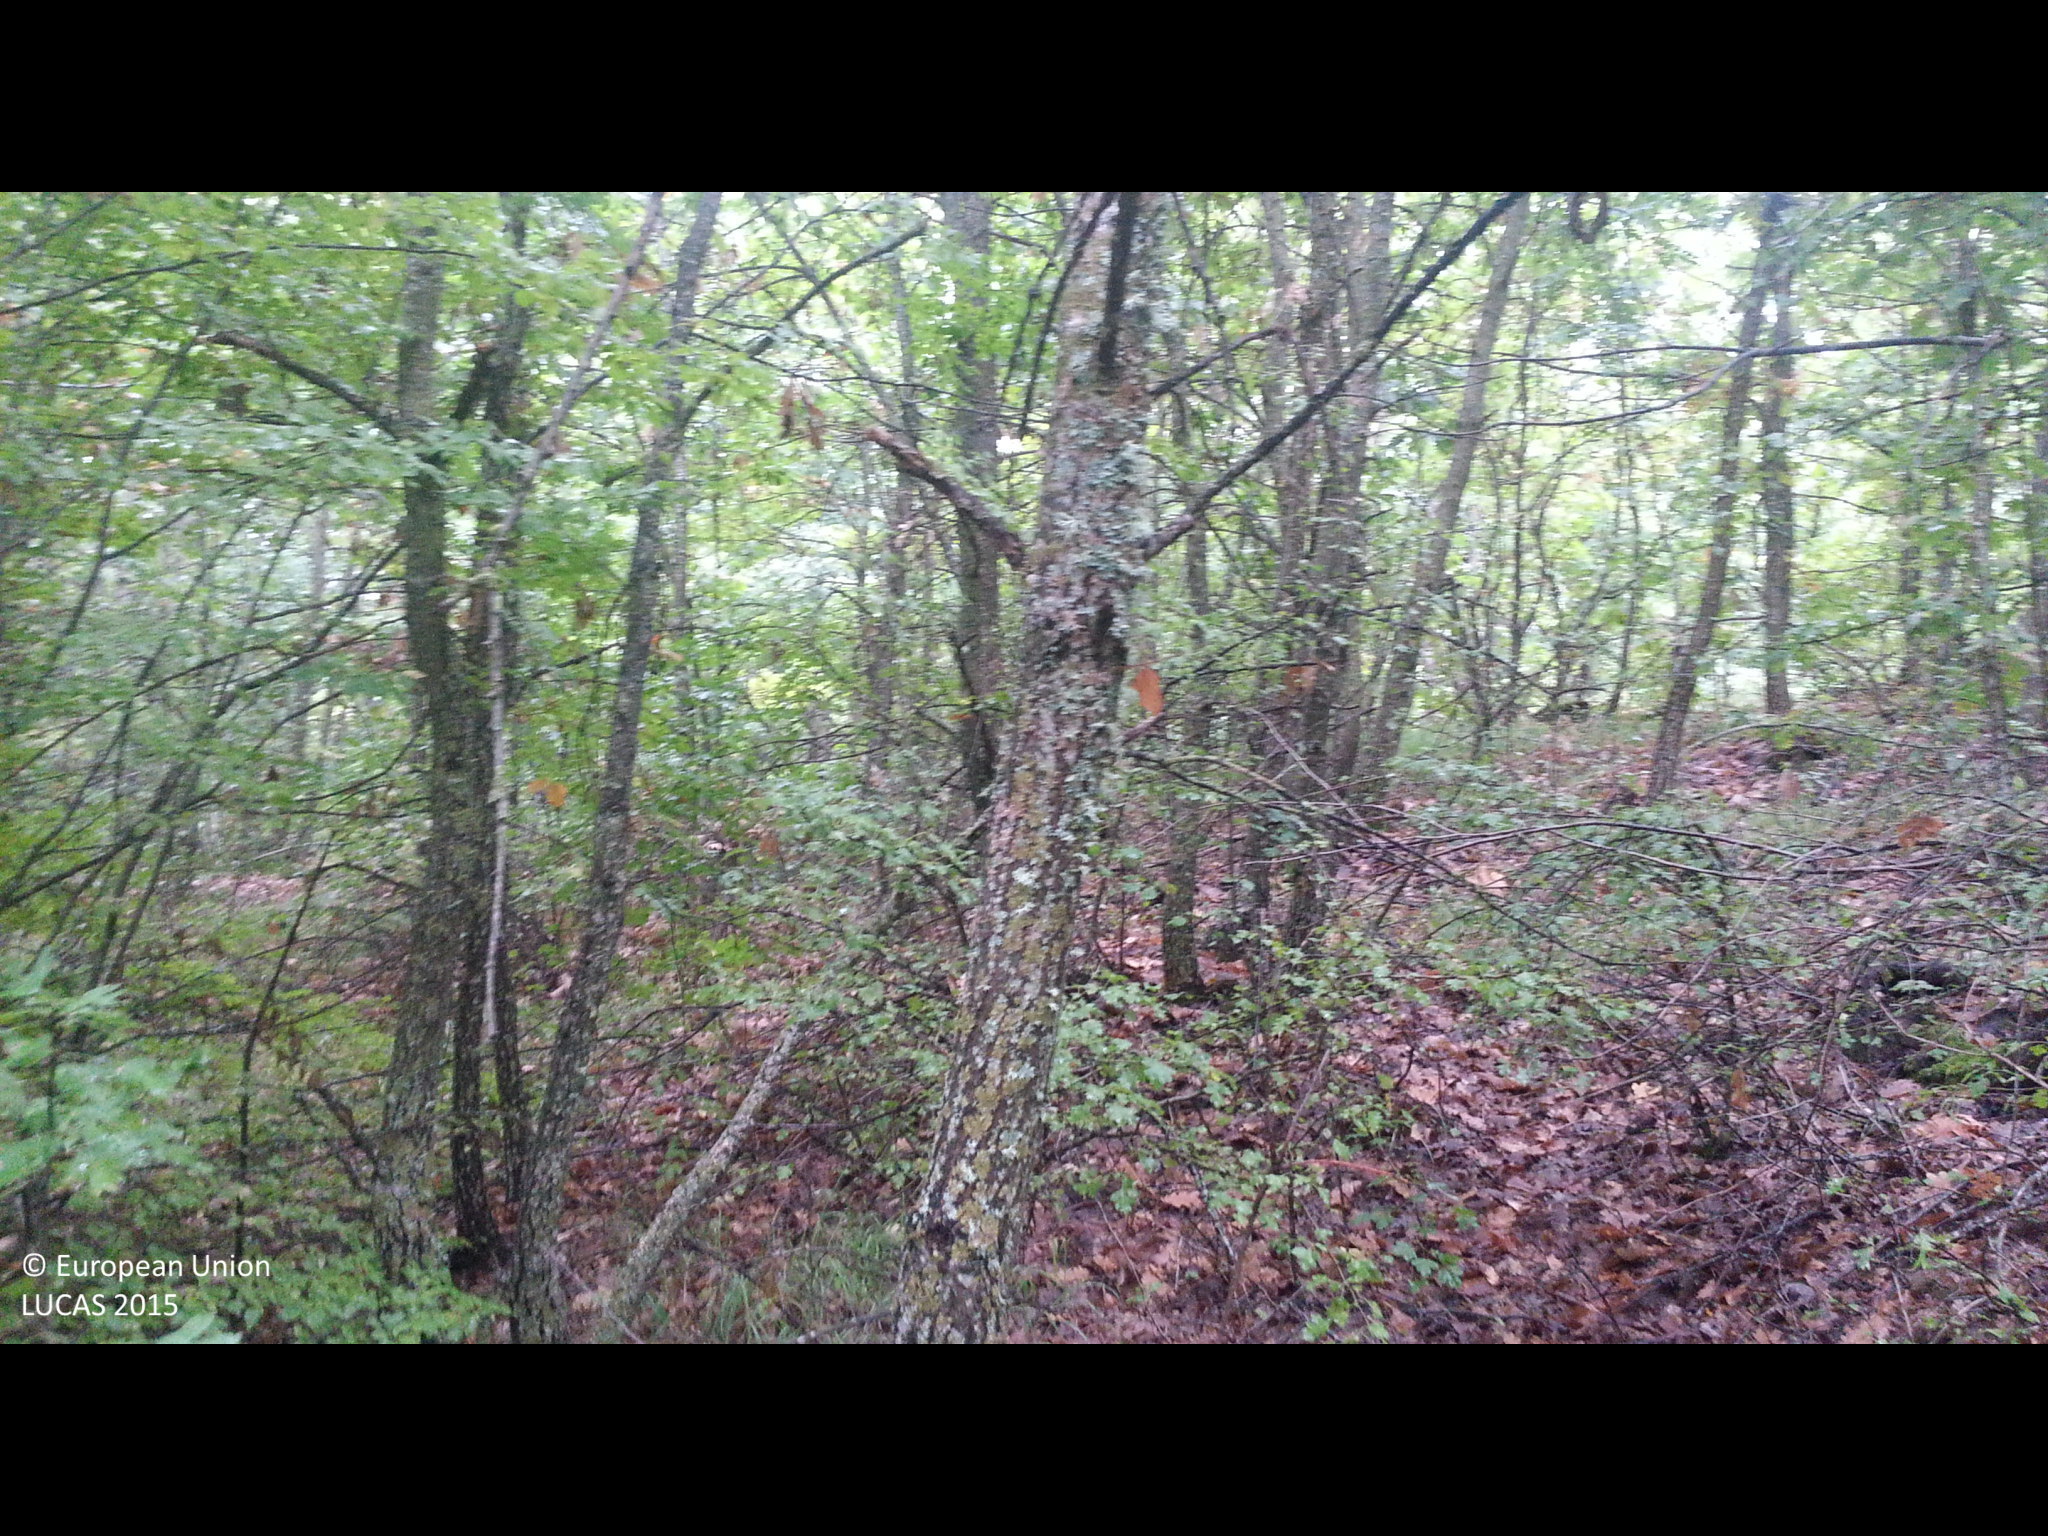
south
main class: Woodland
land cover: Broadleaved woodland
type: mesophytic deciduous forest
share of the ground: > 75 %
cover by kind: broadleaved forest trees 85 %, shrubs 15 %
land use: Forestry
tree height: < 5 m
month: September
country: BG
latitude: 42.5239
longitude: 22.7210
